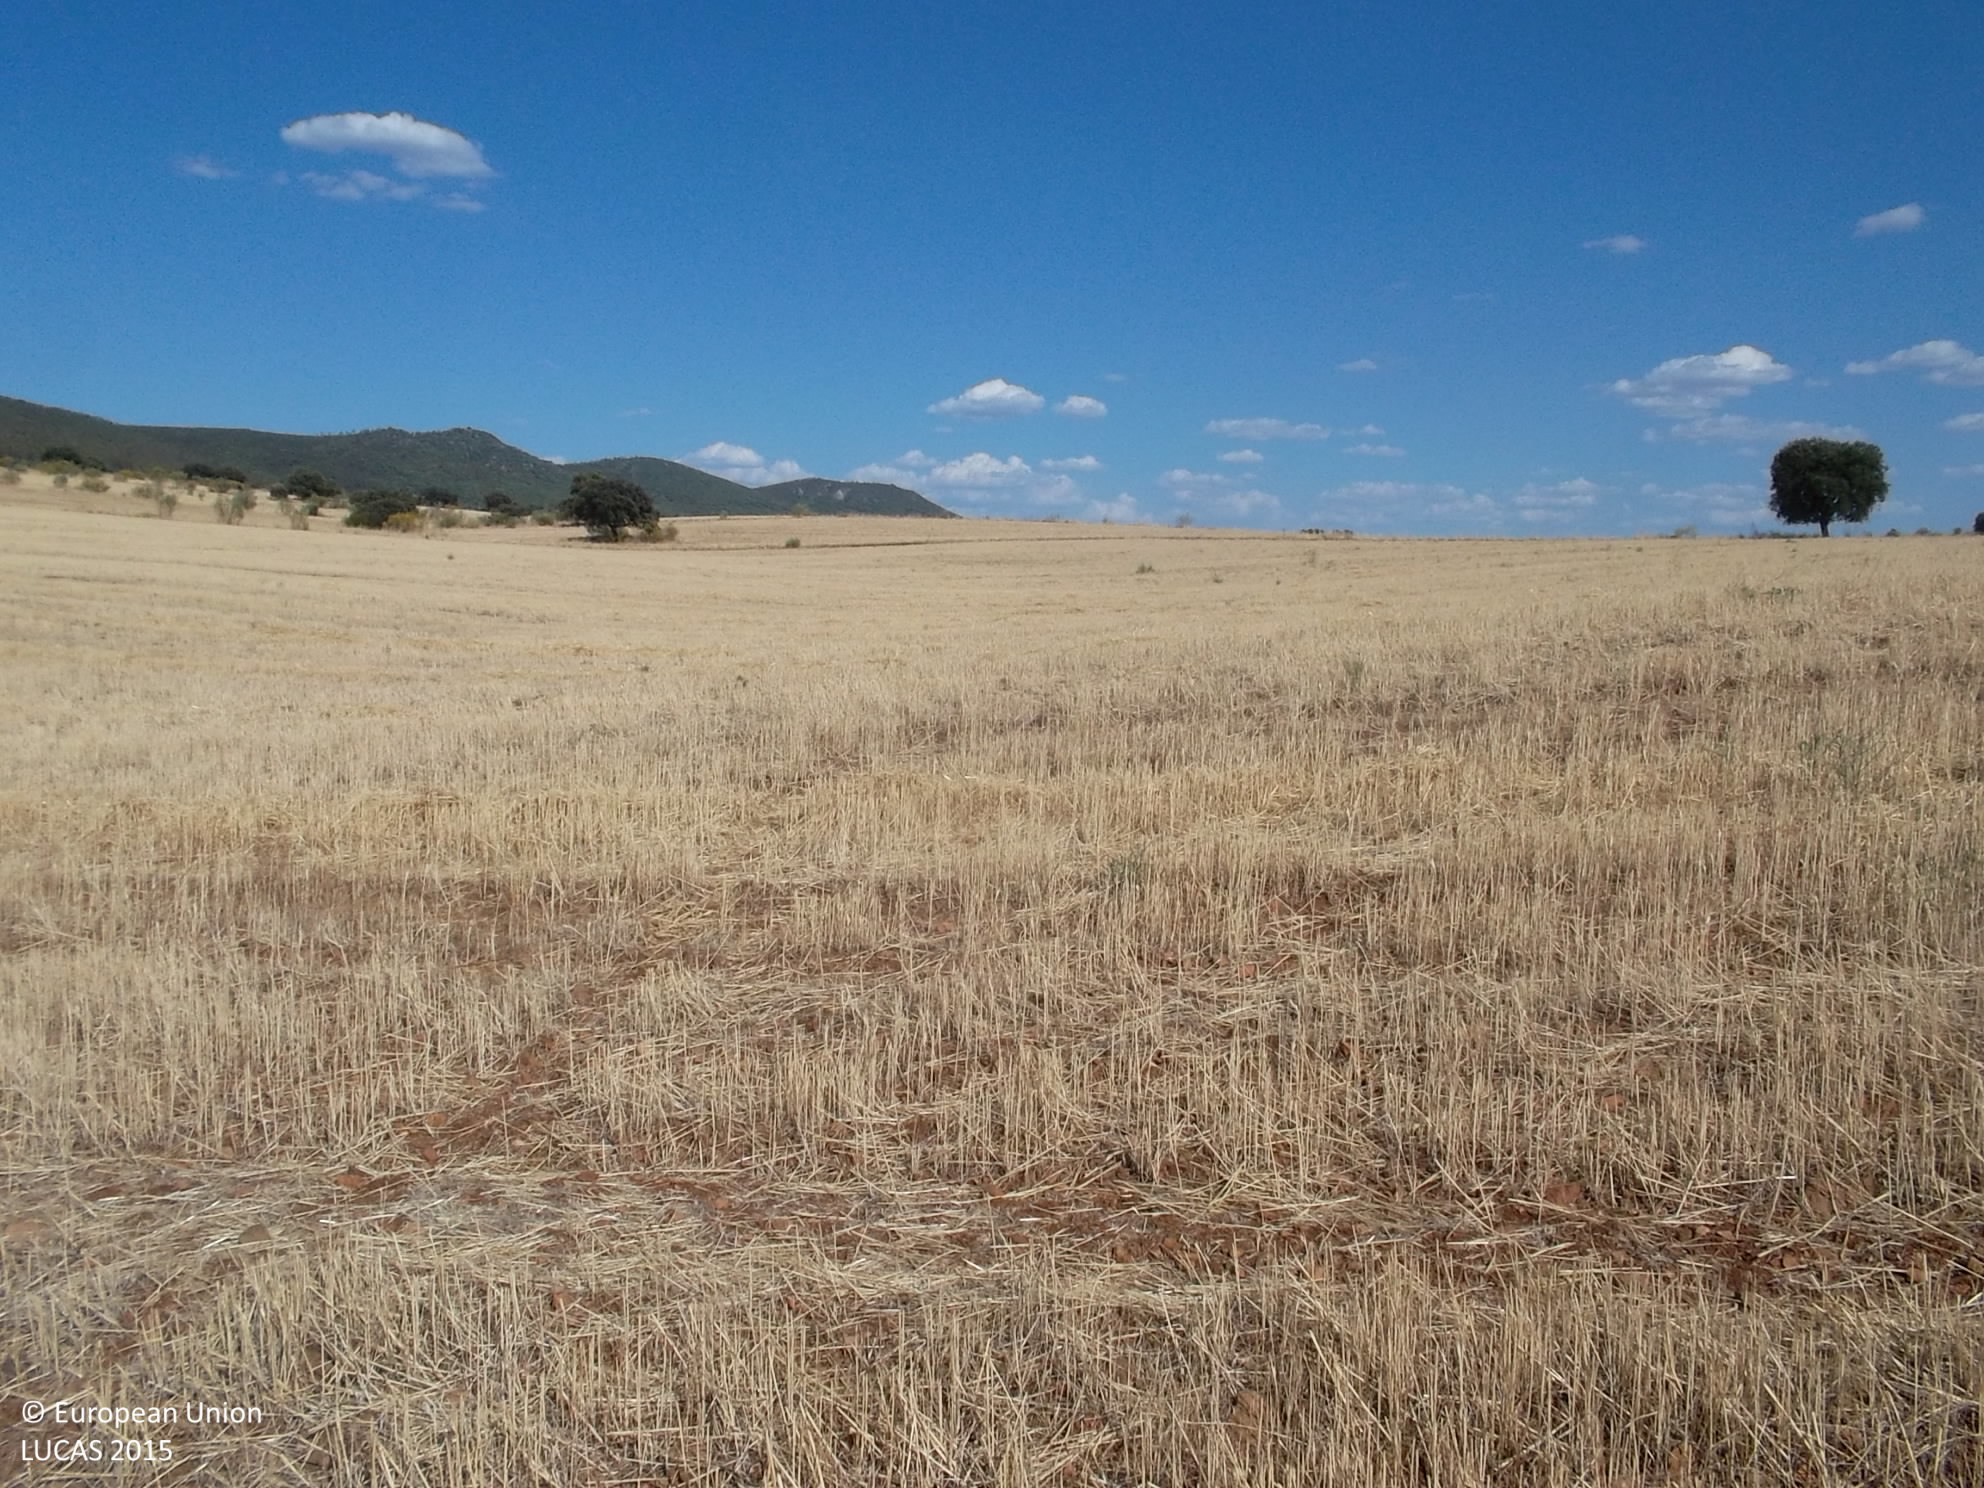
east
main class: Cropland
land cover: Durum wheat
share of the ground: < 10 %
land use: Agriculture (excluding fallow land and kitchen gardens)
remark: Harvested field
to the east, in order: Durum wheat; Grass margins; Oats
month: July
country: ES
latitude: 38.5766
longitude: -5.7785
